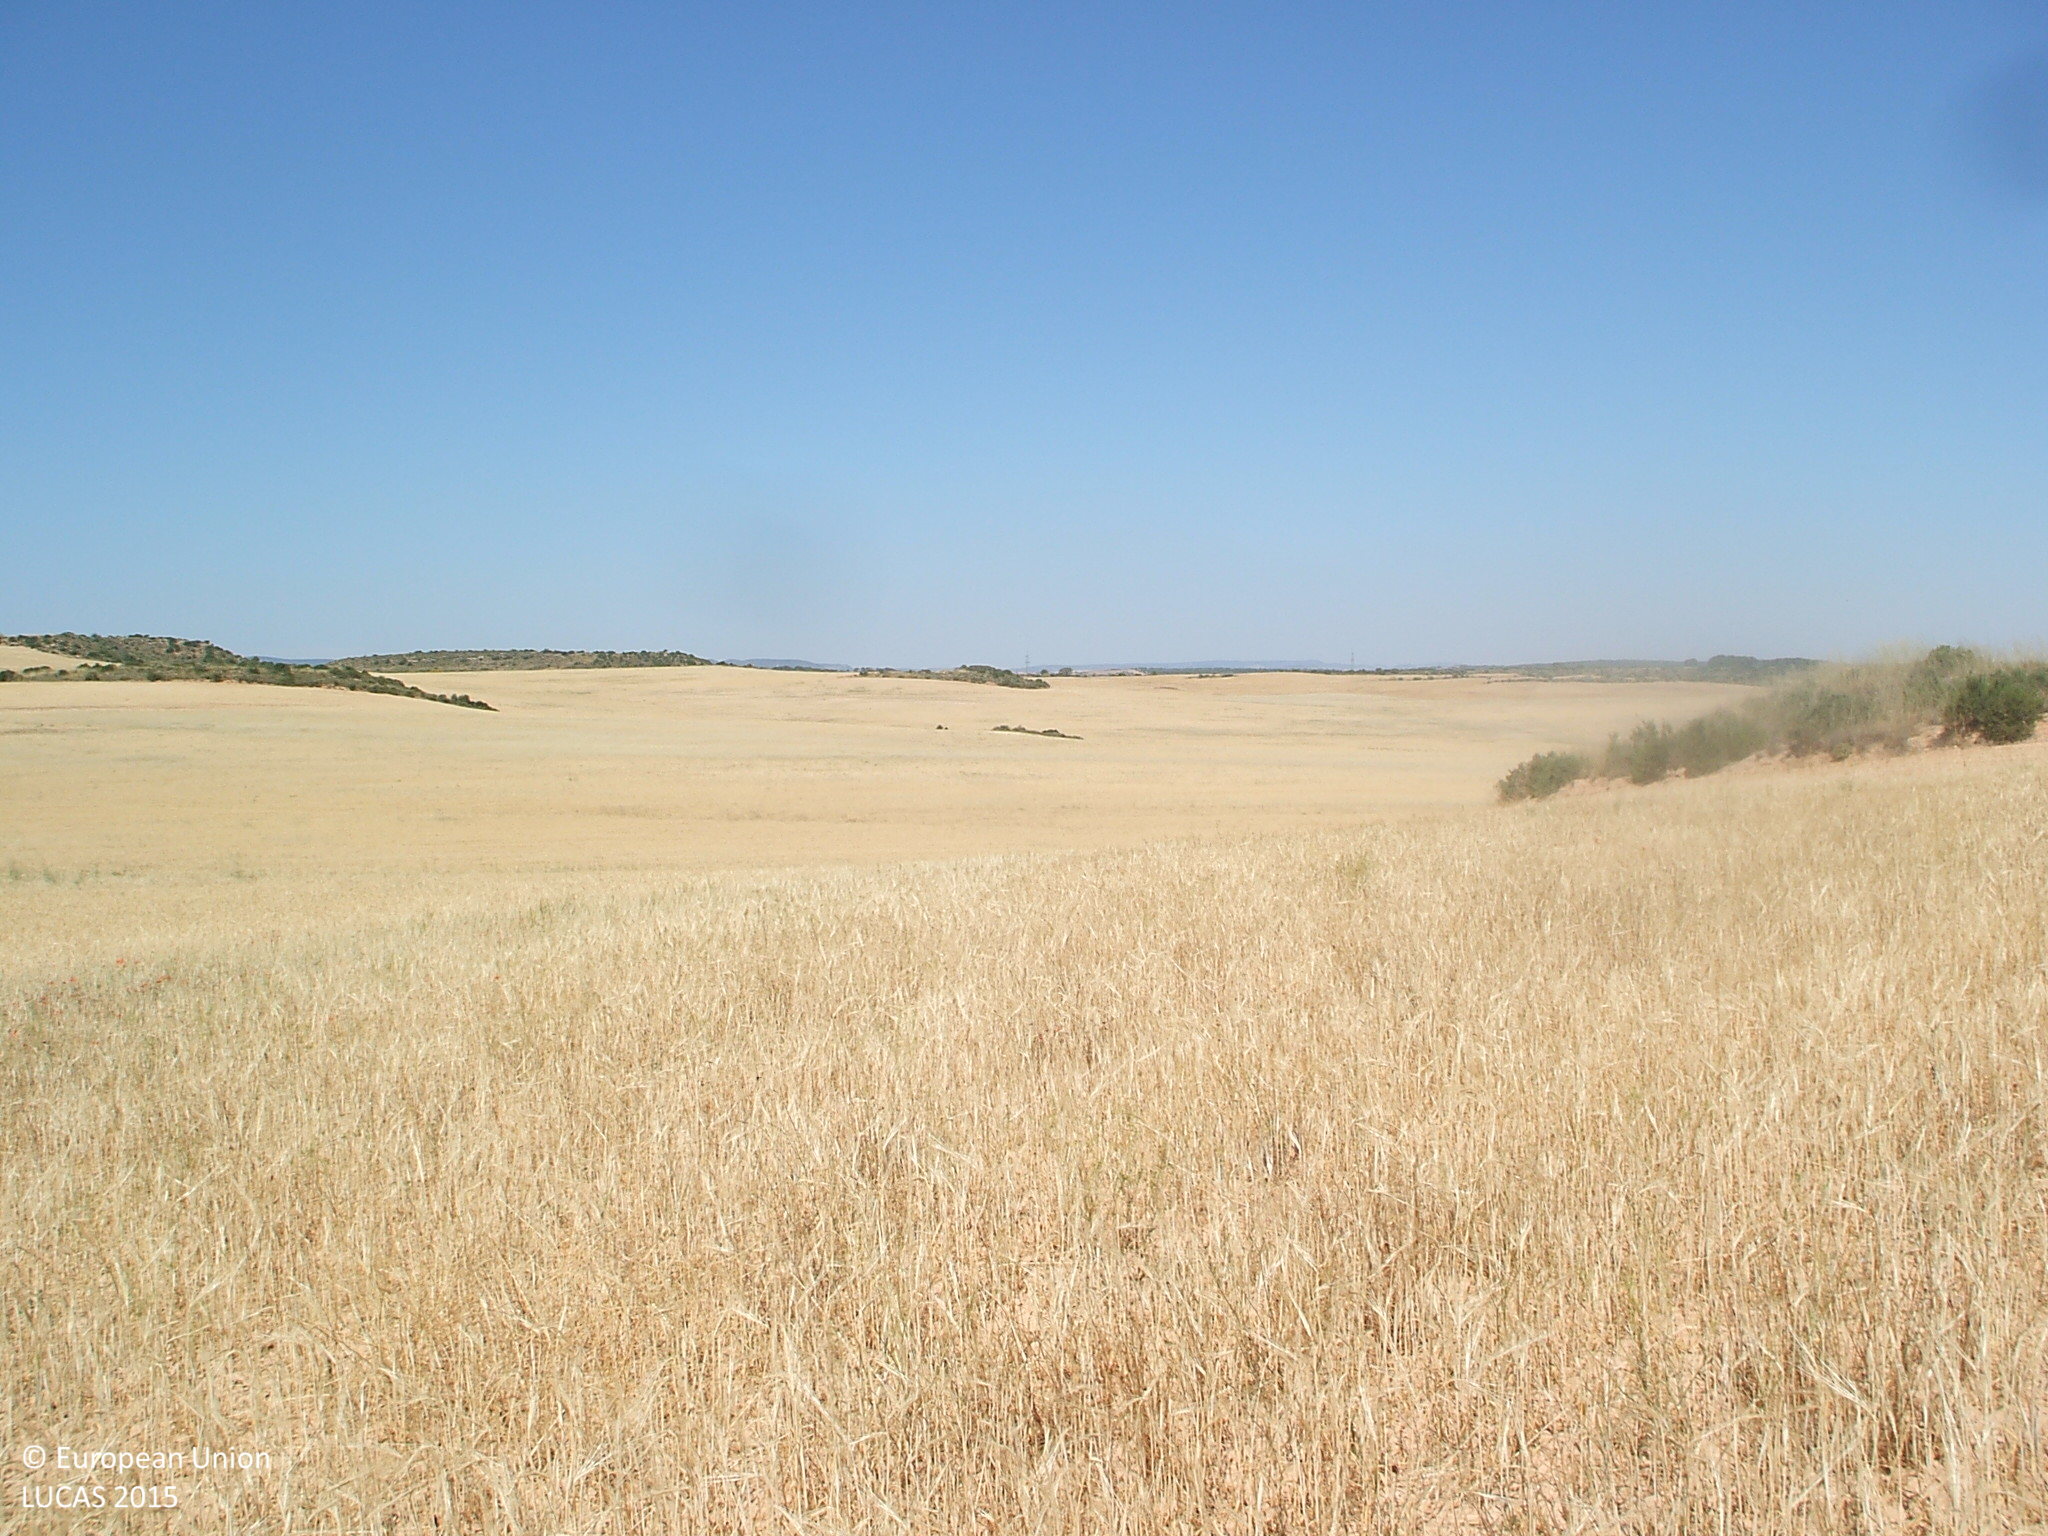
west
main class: Cropland
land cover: Barley
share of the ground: > 75 %
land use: Agriculture (excluding fallow land and kitchen gardens)
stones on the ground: > 50 %
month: June
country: ES
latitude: 41.0508
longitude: -0.3278
